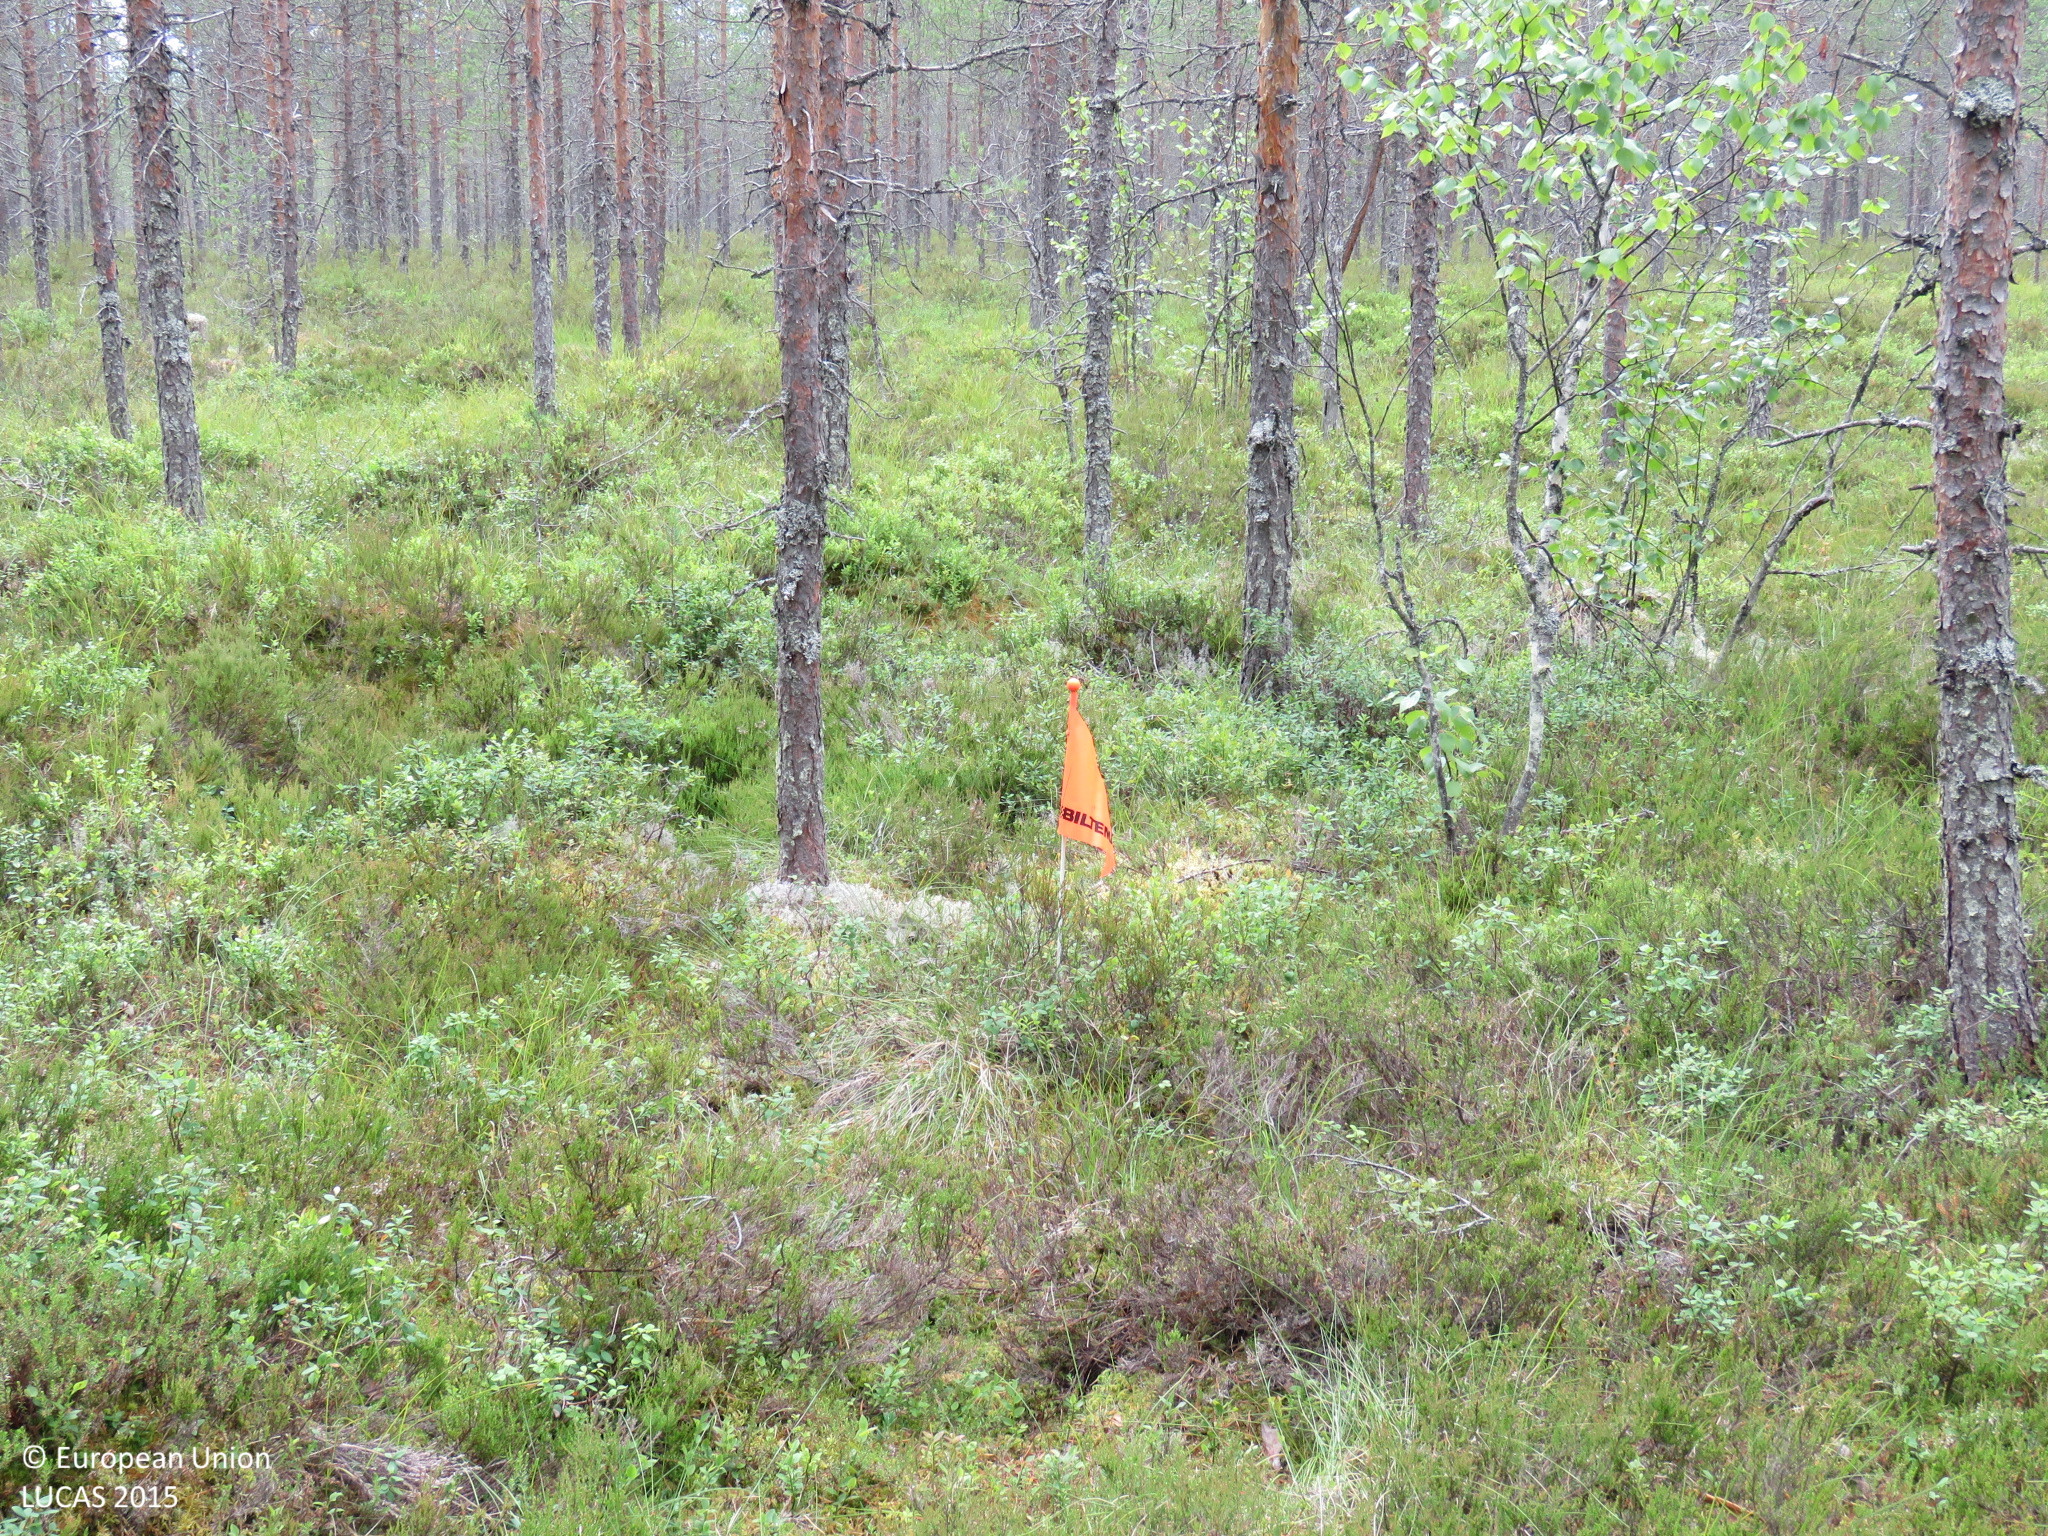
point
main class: Woodland
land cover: Pine dominated coniferous woodland
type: mire and swamp forests
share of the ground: 50 - 75 %
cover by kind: coniferous forest trees 45 %, shrubs 30 %, broadleaved forest trees 10 %, lichens and mosses 10 %, herbaceous plants 5 %
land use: Forestry
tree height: > 5 m
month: July
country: FI
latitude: 64.6391
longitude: 26.8410
